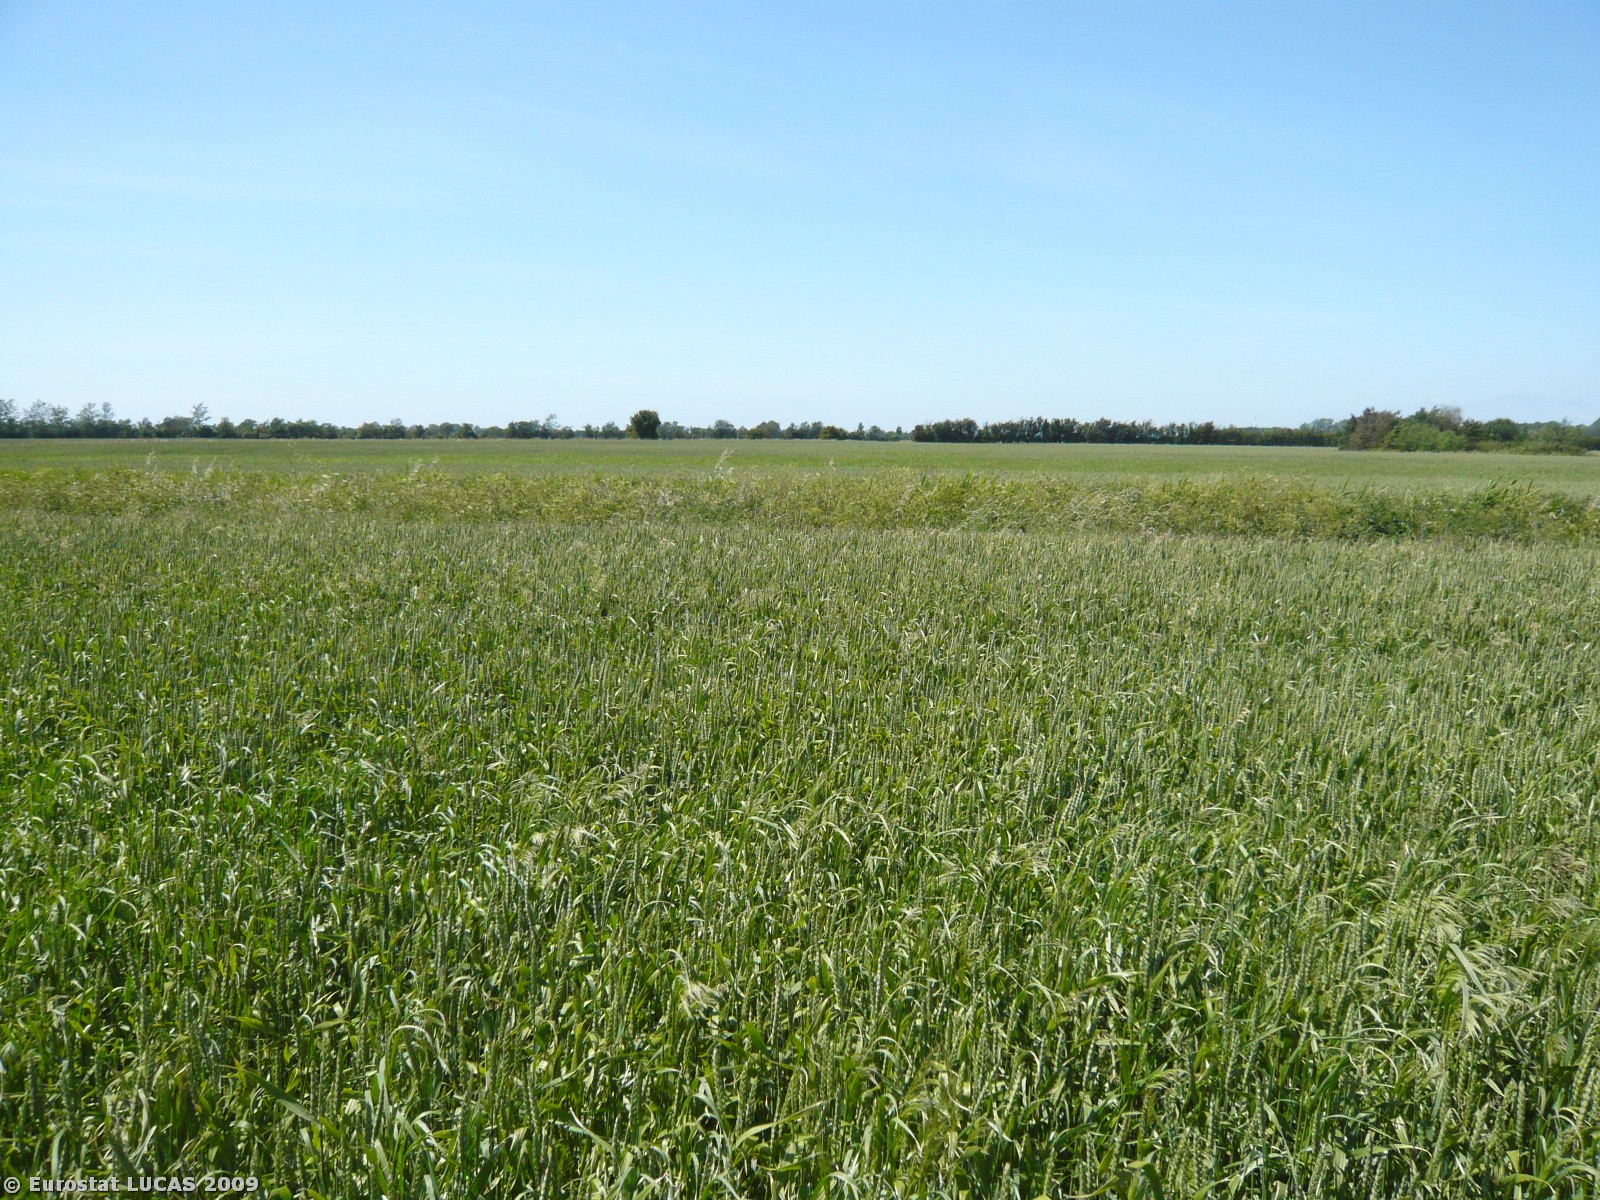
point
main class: Cropland
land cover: Common wheat
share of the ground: > 75 %
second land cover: Barley
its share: 10 - 25 %
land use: Agriculture (excluding fallow land and kitchen gardens)
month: June
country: DK
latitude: 54.7252
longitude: 11.2879
